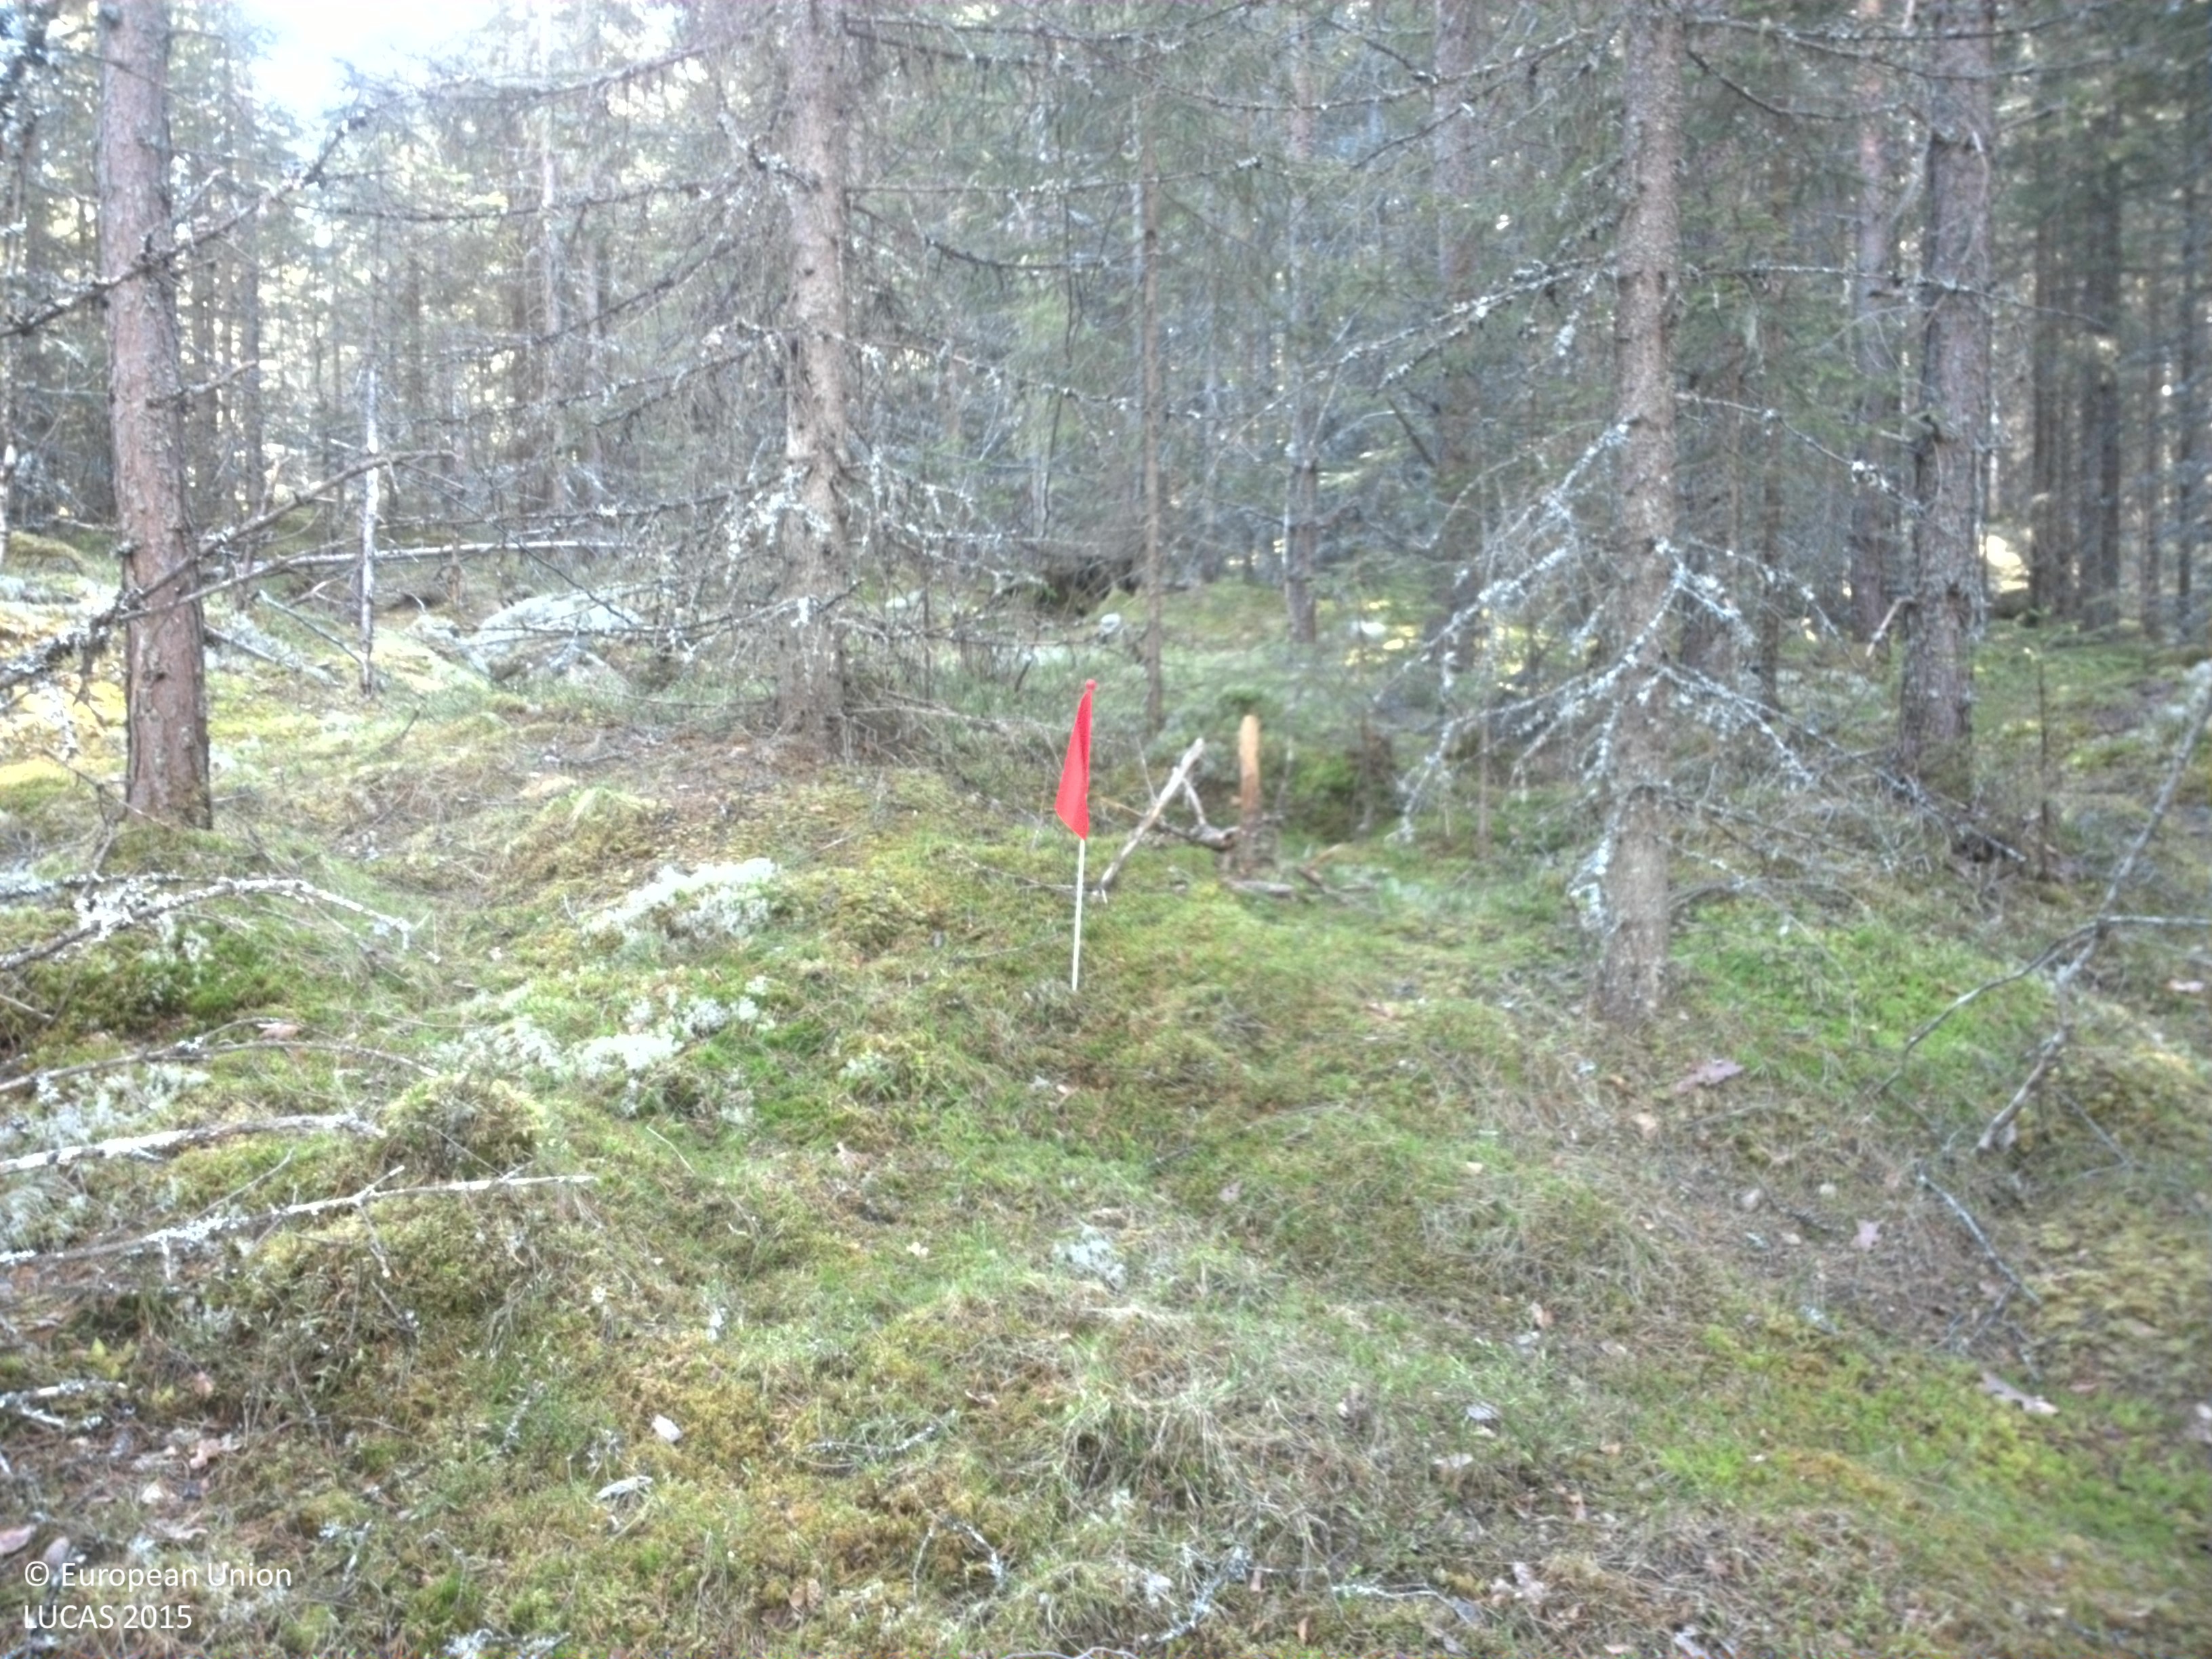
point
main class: Woodland
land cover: Spruce dominated mixed woodland
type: boreal forest
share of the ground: > 75 %
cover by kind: coniferous forest trees 65 %, broadleaved forest trees 25 %, shrubs 10 %
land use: Forestry
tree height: > 5 m
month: May
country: SE
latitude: 60.9706
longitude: 12.4116
